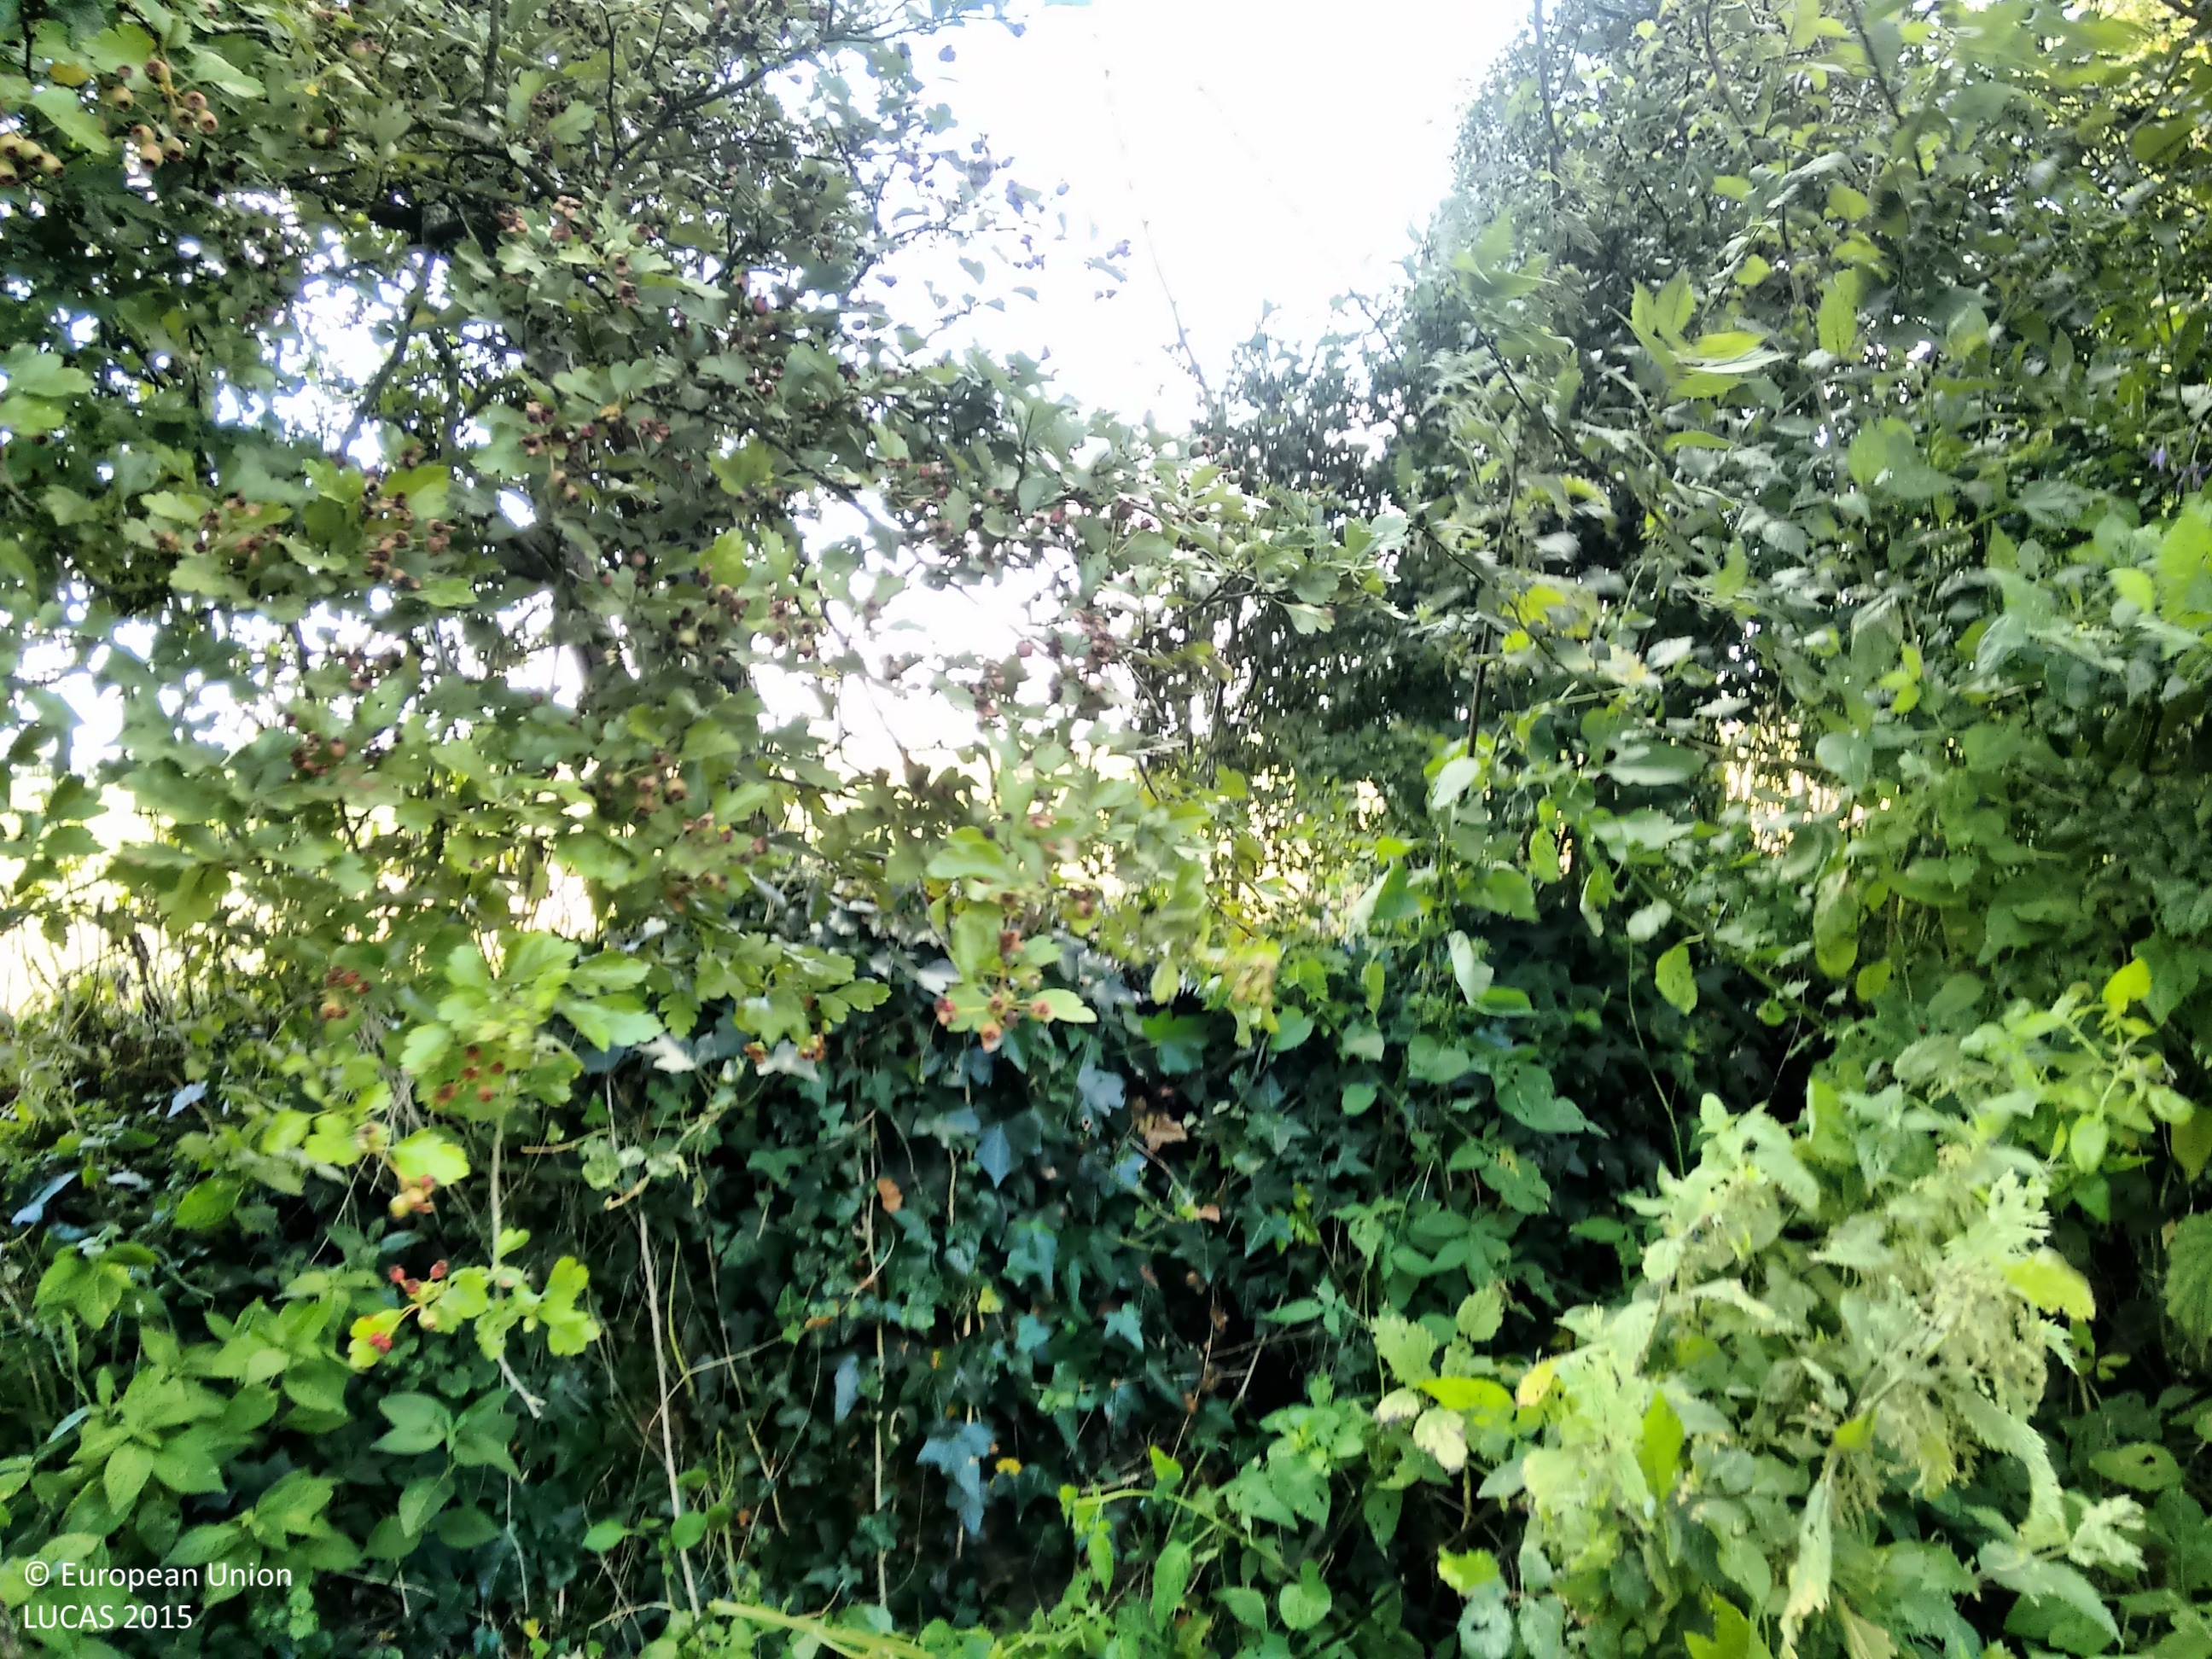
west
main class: Grassland
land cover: Grassland without tree/shrub cover
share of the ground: > 75 %
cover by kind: herbaceous plants 100 %
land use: Agriculture (excluding fallow land and kitchen gardens)
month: August
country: GB
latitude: 52.0591
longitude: 0.3888
